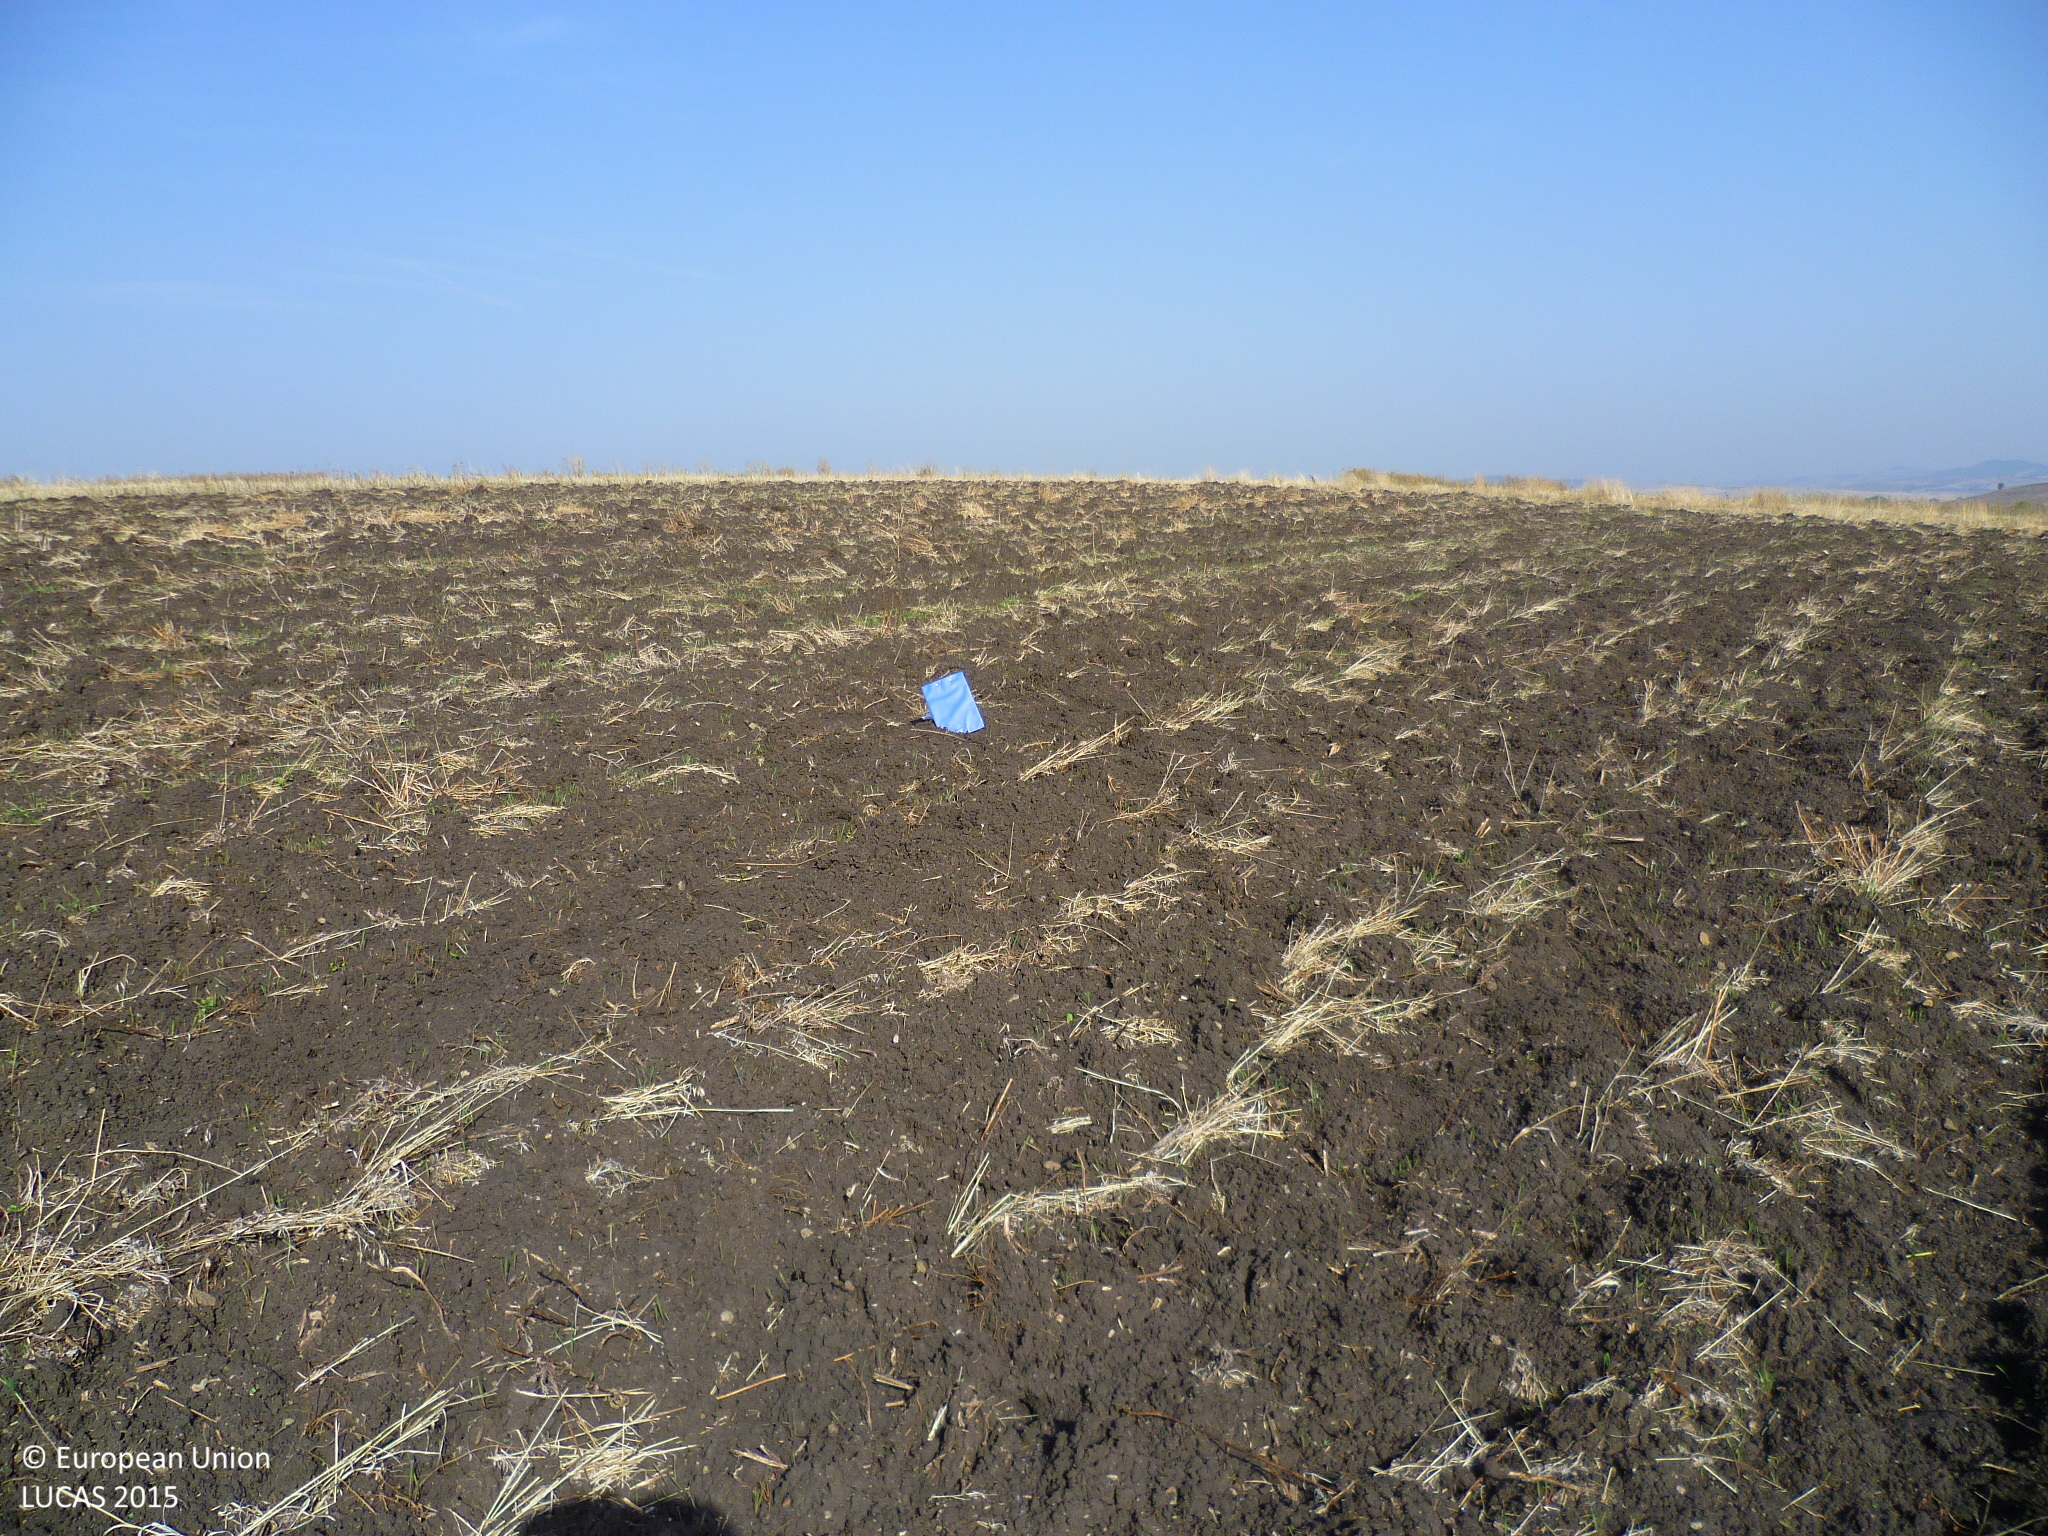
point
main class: Cropland
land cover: Rape and turnip rape
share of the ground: < 10 %
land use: Agriculture (excluding fallow land and kitchen gardens)
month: September
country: BG
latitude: 42.6561
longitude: 22.9720
